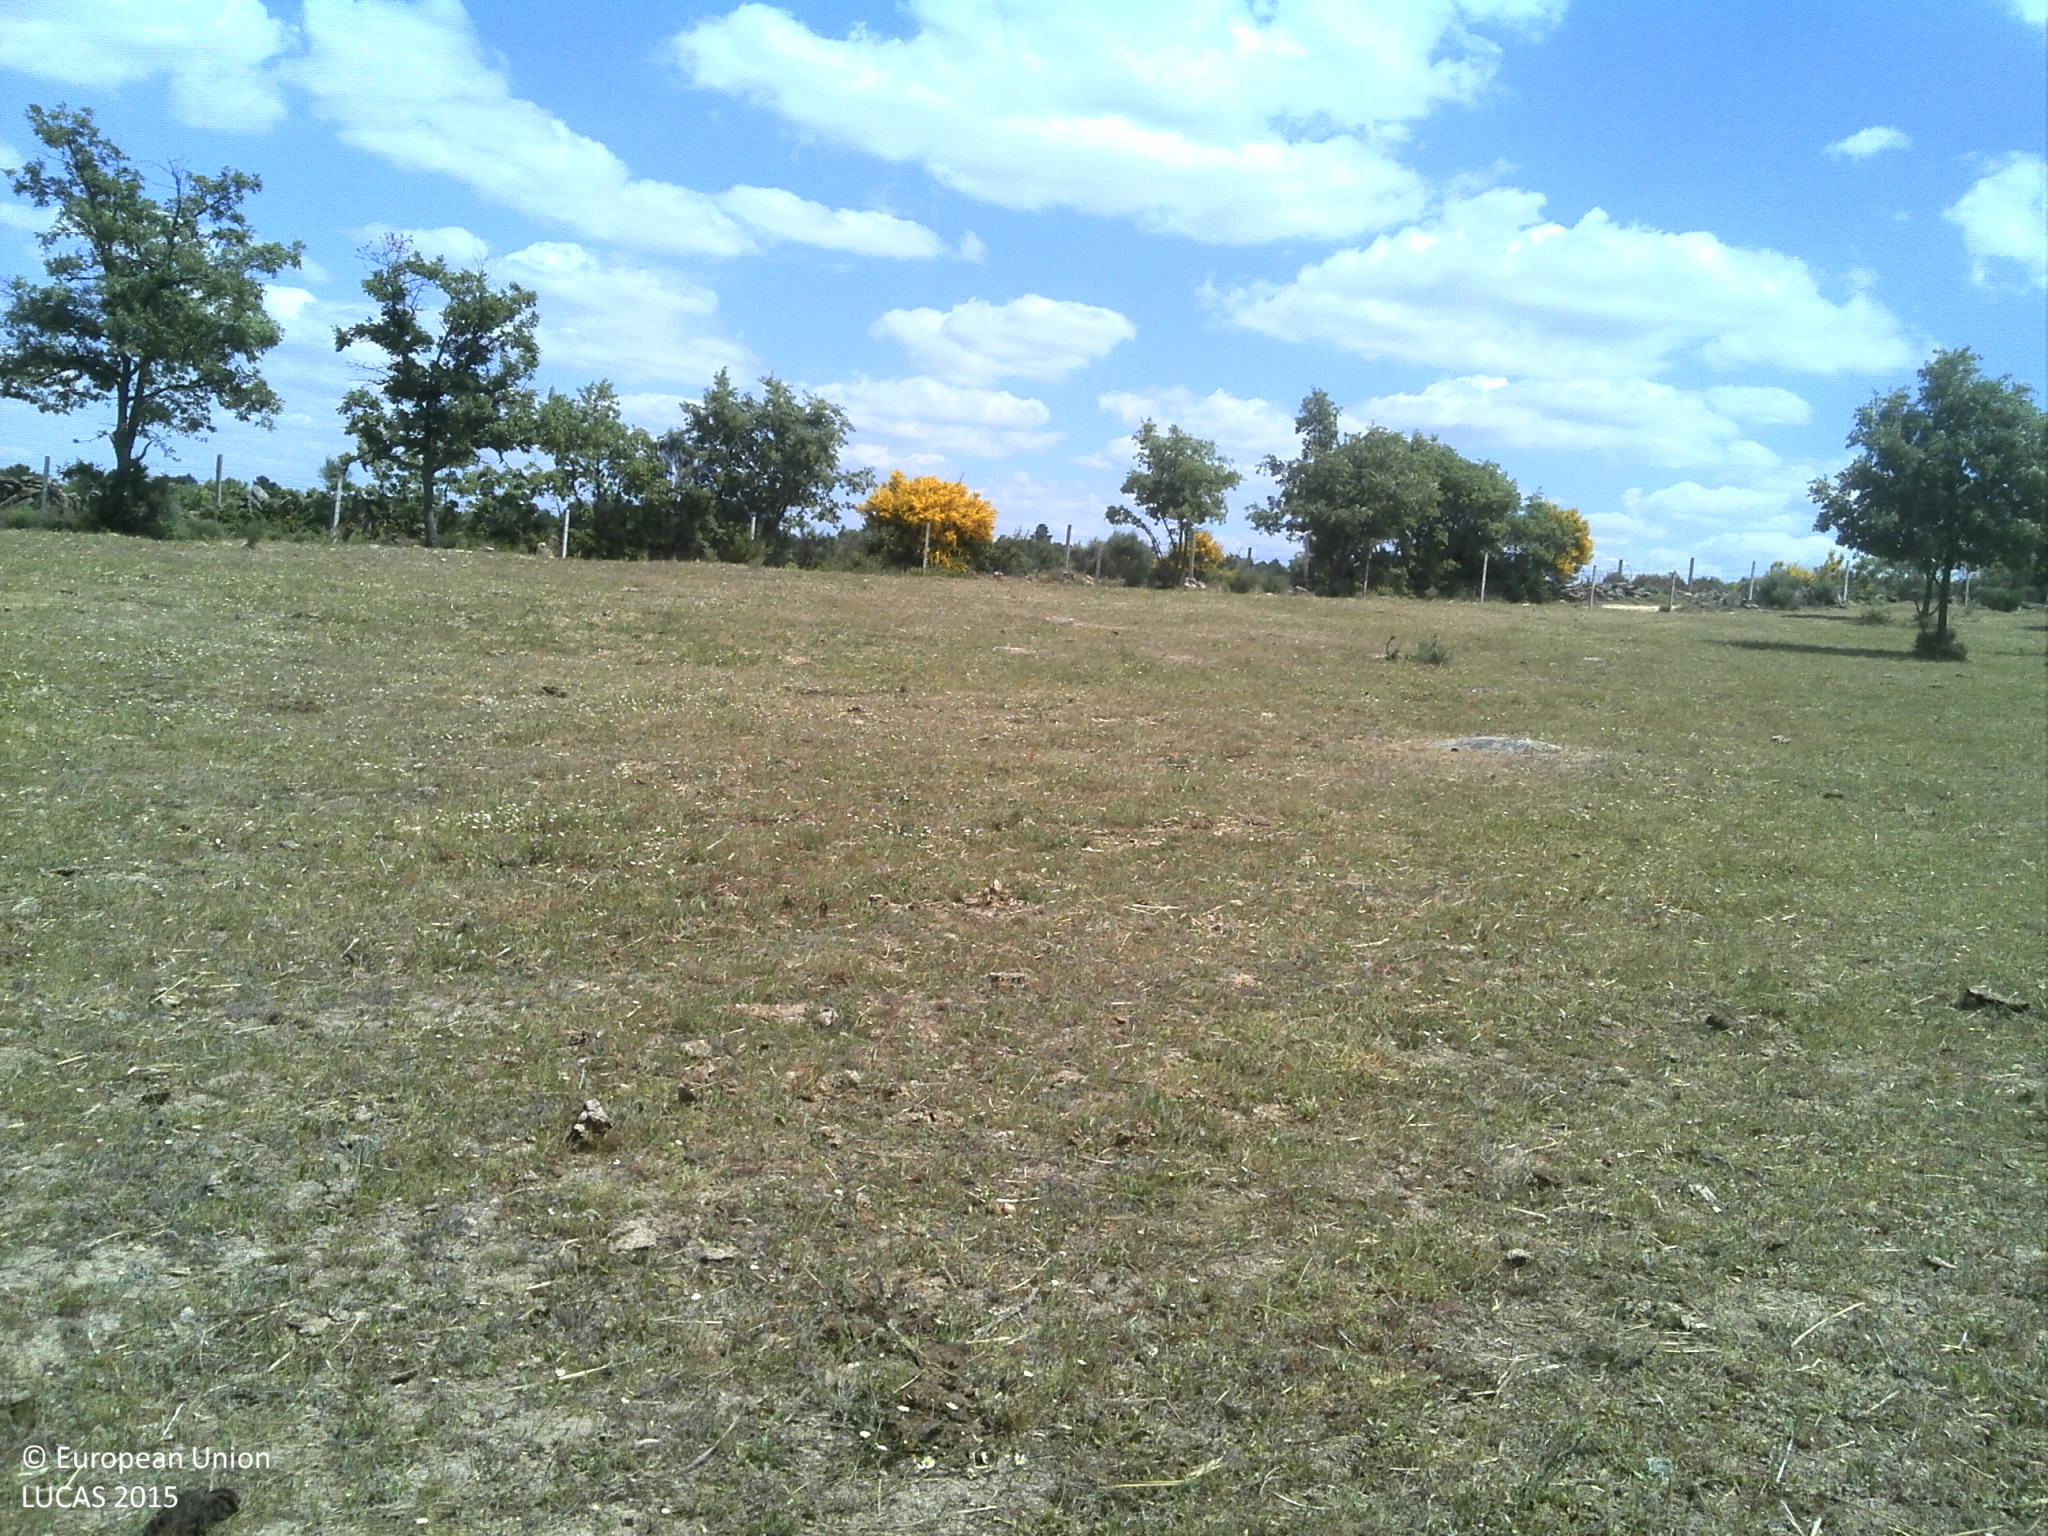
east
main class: Grassland
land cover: Grassland without tree/shrub cover
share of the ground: 25 - 50 %
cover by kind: herbaceous plants 70 %, unconsolidated bare surface 15 %
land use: Agriculture (excluding fallow land and kitchen gardens)
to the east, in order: Grassland without tree/shrub cover; Fences; Tracks; Lines of trees; Dry stone walls; Fences; Spontaneously vegetated surfaces; Inland fresh water bodies; Spontaneously vegetated surfaces; Shrubland without tree cover
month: May
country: PT
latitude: 40.6665
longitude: -7.1266
